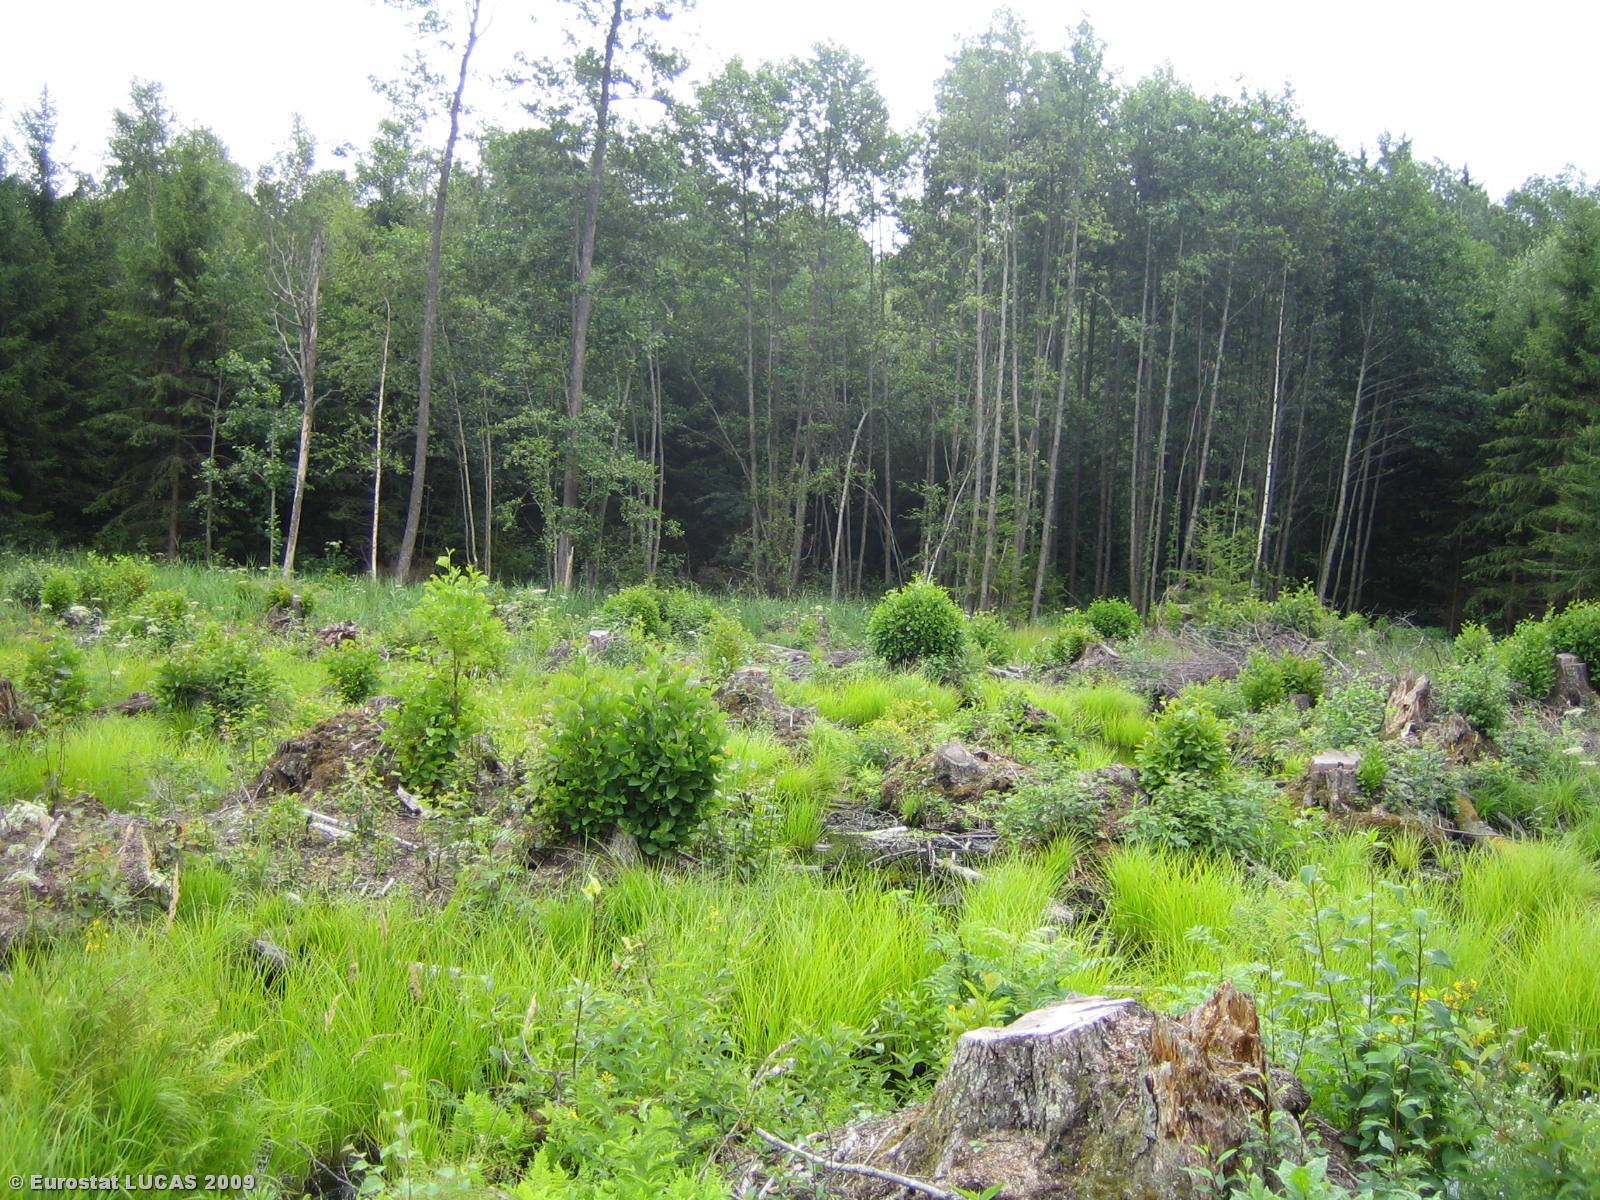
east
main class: Shrubland
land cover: Shrubland with sparse tree cover
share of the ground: 25 - 50 %
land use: Forestry
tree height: > 5 m
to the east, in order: Shrubland with sparse tree cover; Tracks; Mixed woodland; Inland marshes; Mixed woodland
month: July
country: LT
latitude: 55.4485
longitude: 25.5729
